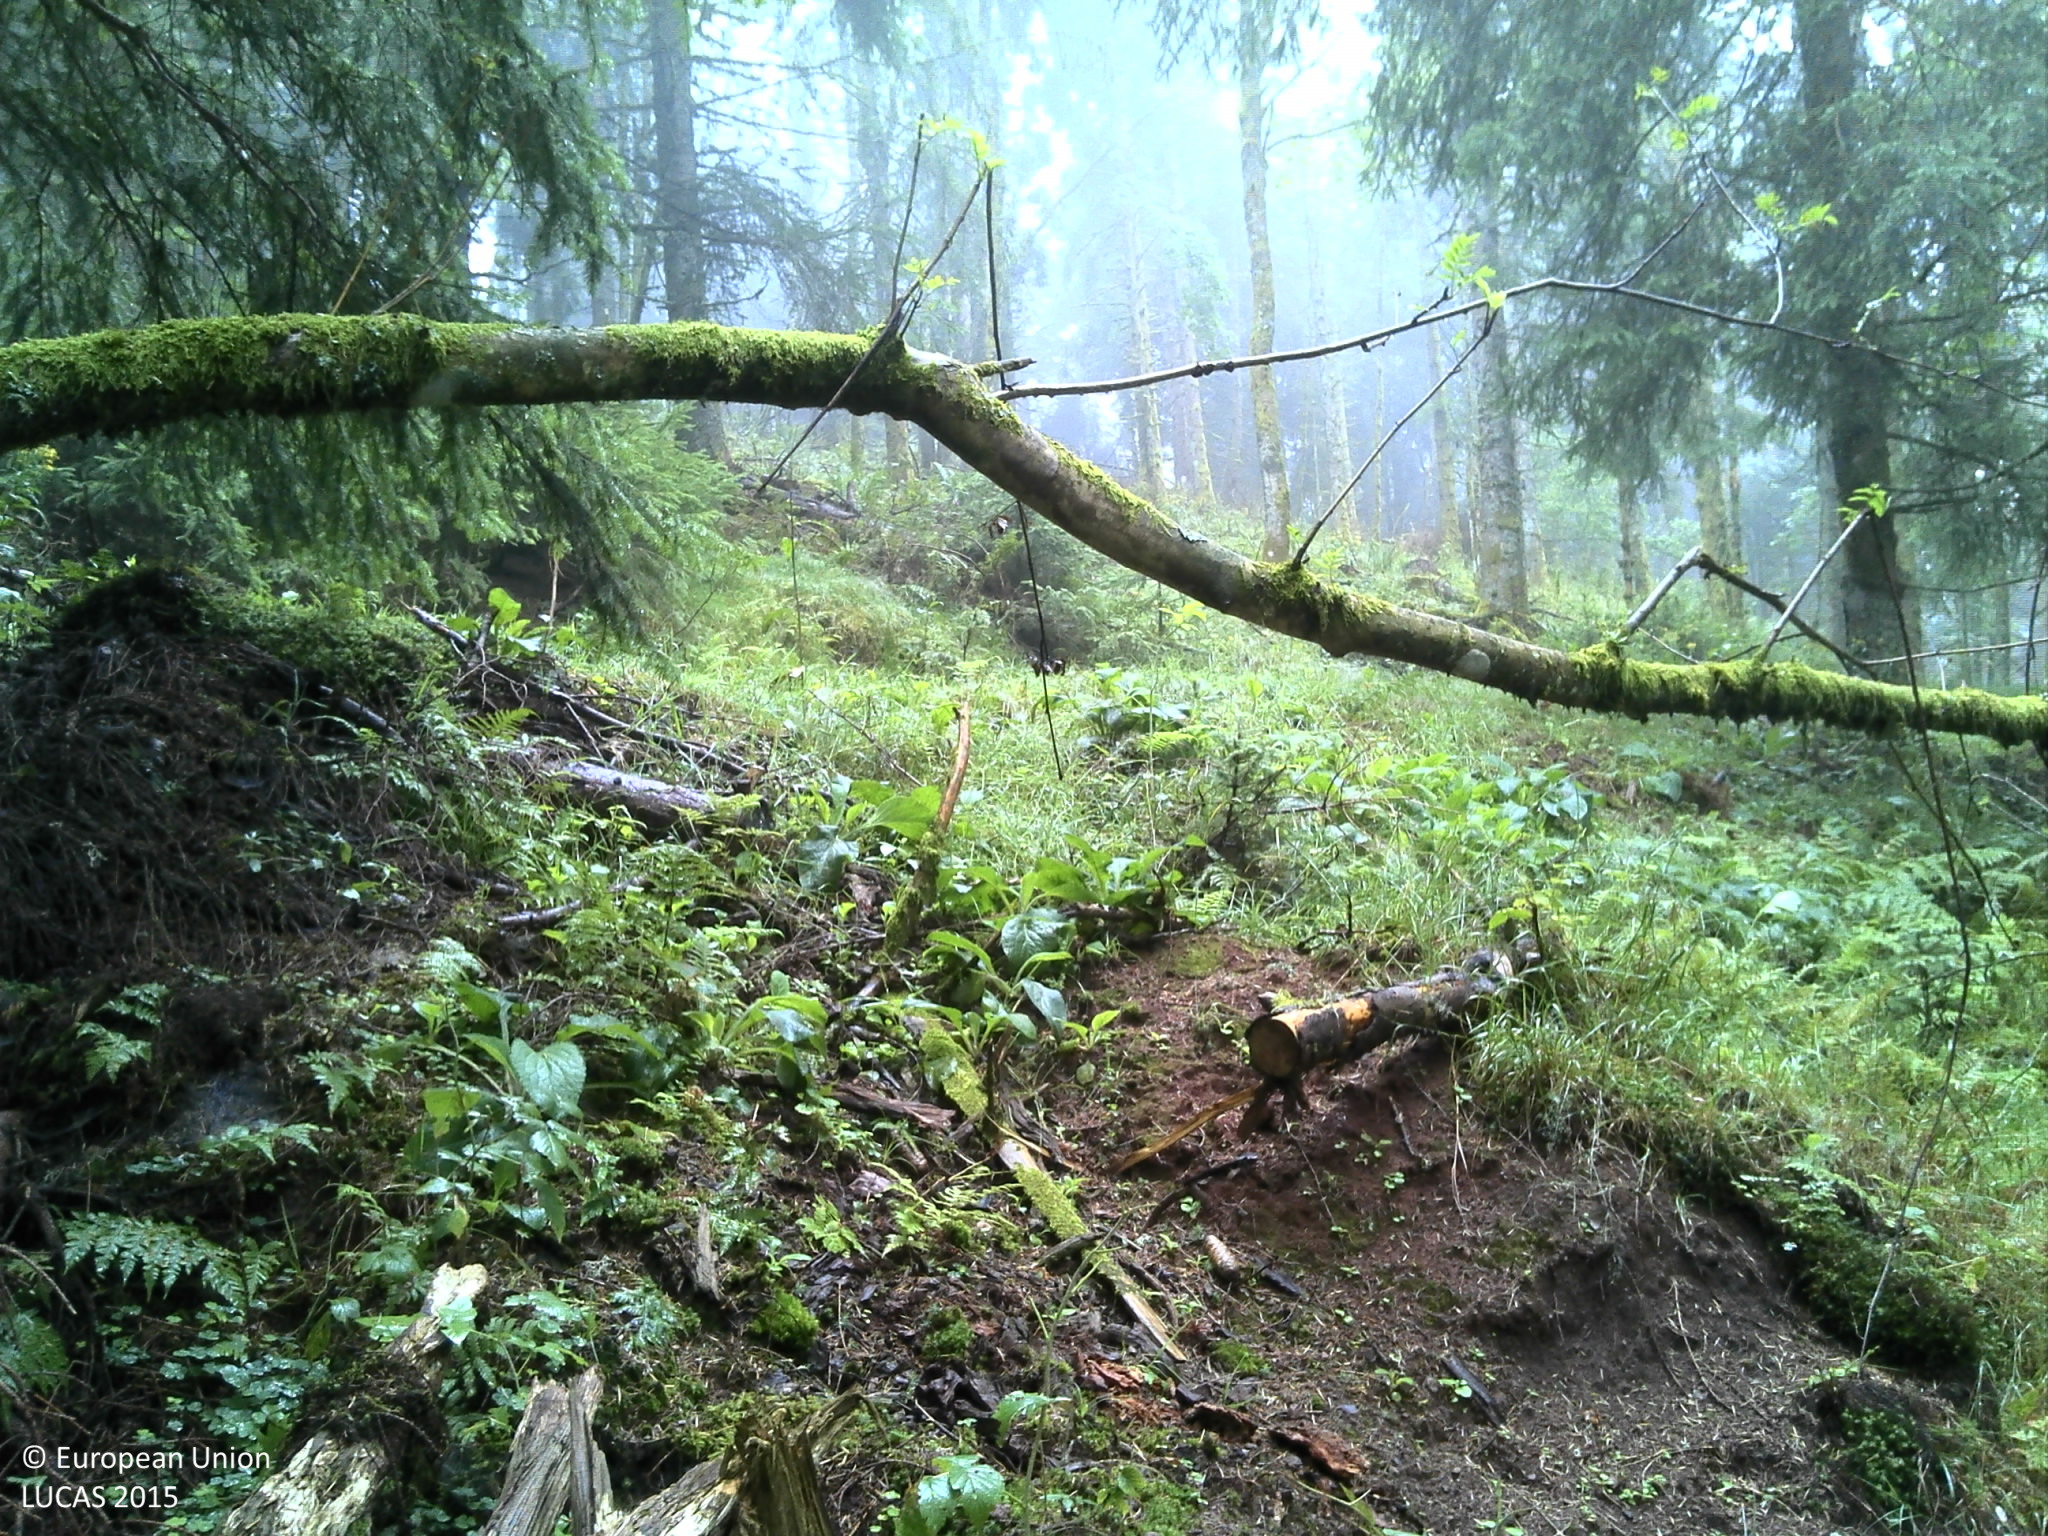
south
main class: Woodland
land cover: Spruce dominated coniferous woodland
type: alpine coniferous forest
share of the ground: > 75 %
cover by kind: coniferous forest trees 90 %, herbaceous plants 10 %
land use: Forestry
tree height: > 5 m
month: August
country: FR
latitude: 47.9806
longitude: 6.8527
